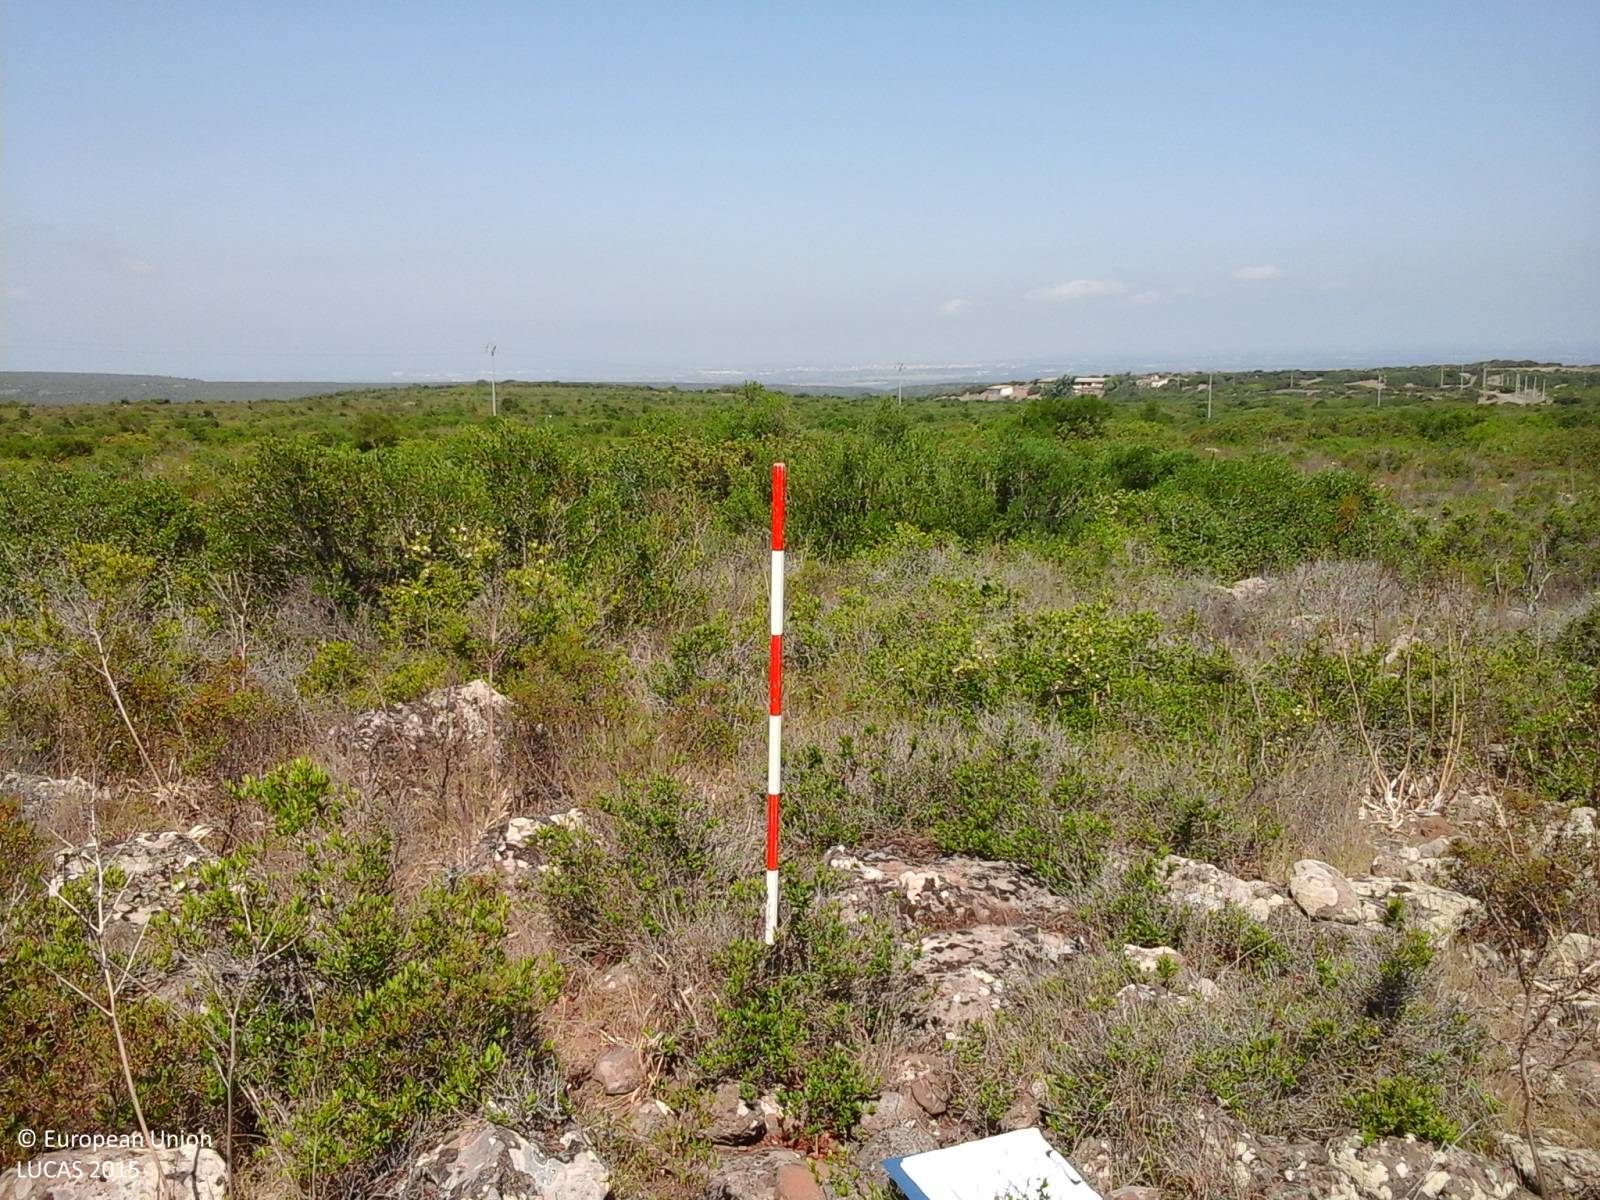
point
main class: Shrubland
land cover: Shrubland without tree cover
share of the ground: > 75 %
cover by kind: shrubs 100 %
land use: Agriculture (excluding fallow land and kitchen gardens)
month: June
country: IT
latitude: 39.8614
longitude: 8.7794
